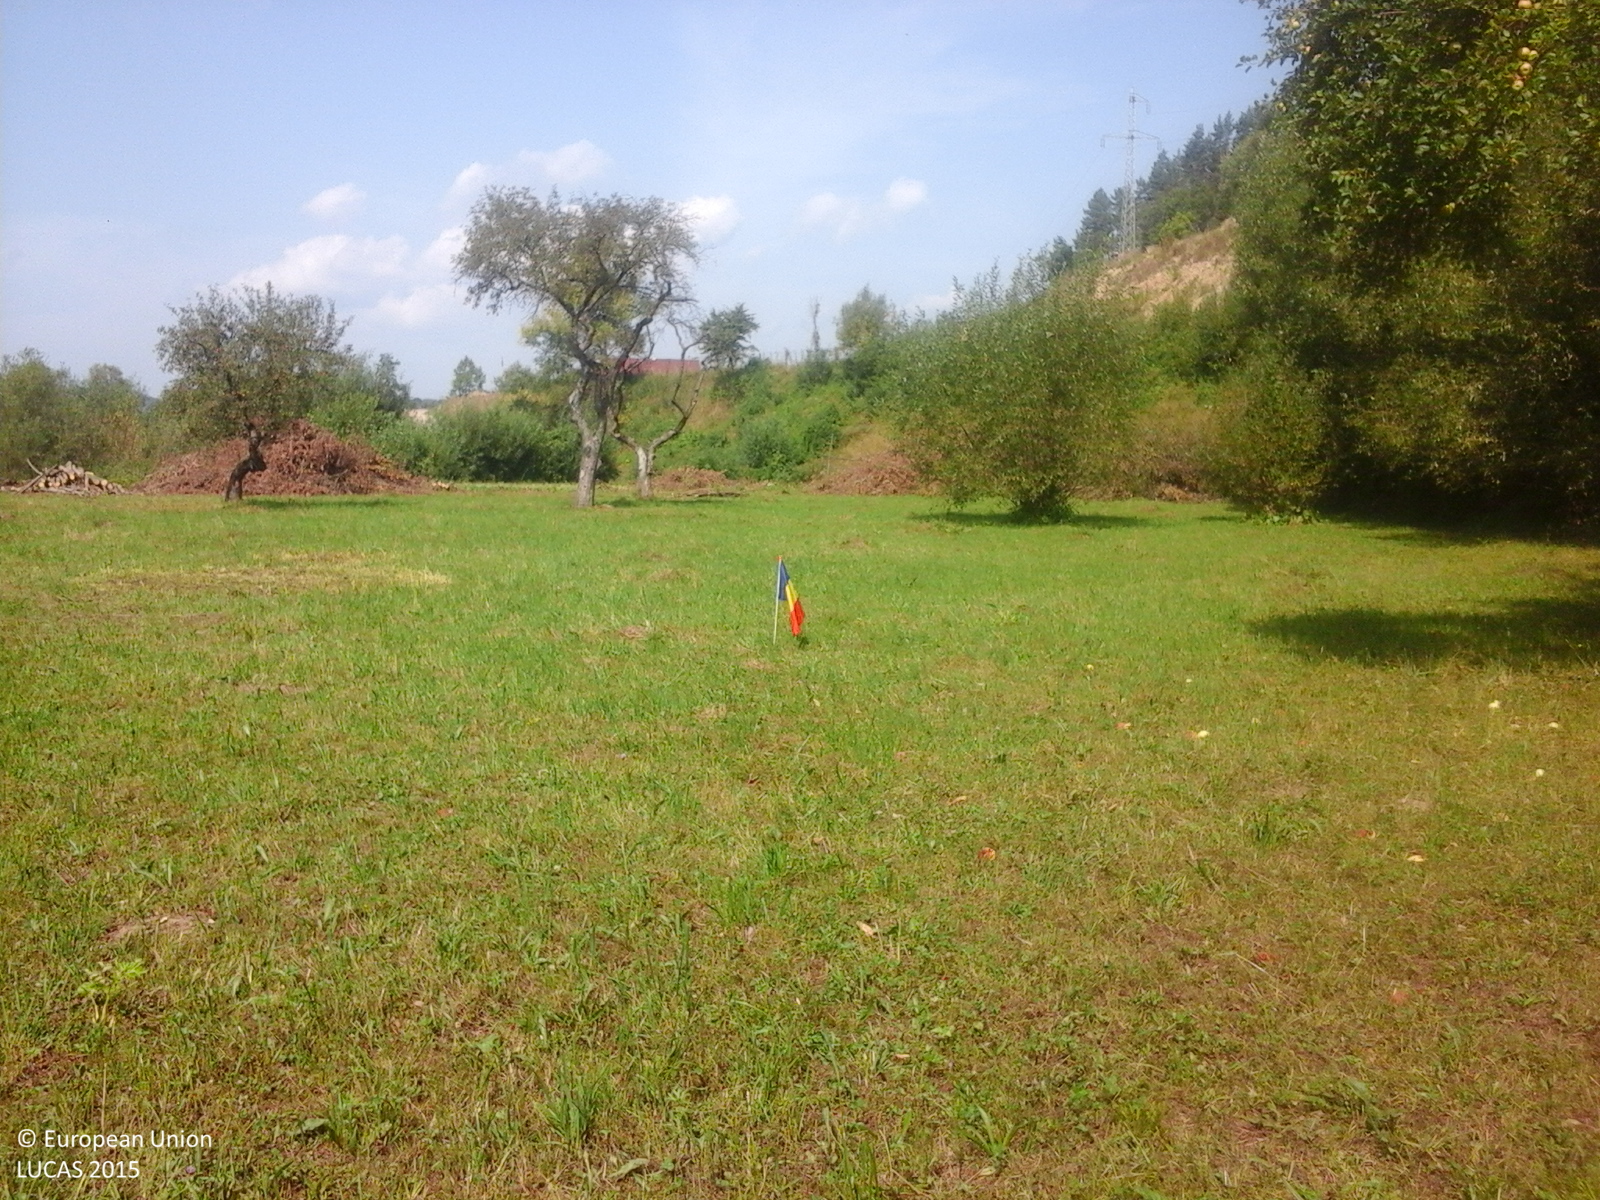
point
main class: Grassland
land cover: Grassland without tree/shrub cover
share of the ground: > 75 %
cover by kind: herbaceous plants 100 %
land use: Agriculture (excluding fallow land and kitchen gardens)
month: September
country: RO
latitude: 47.7814
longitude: 24.2779
